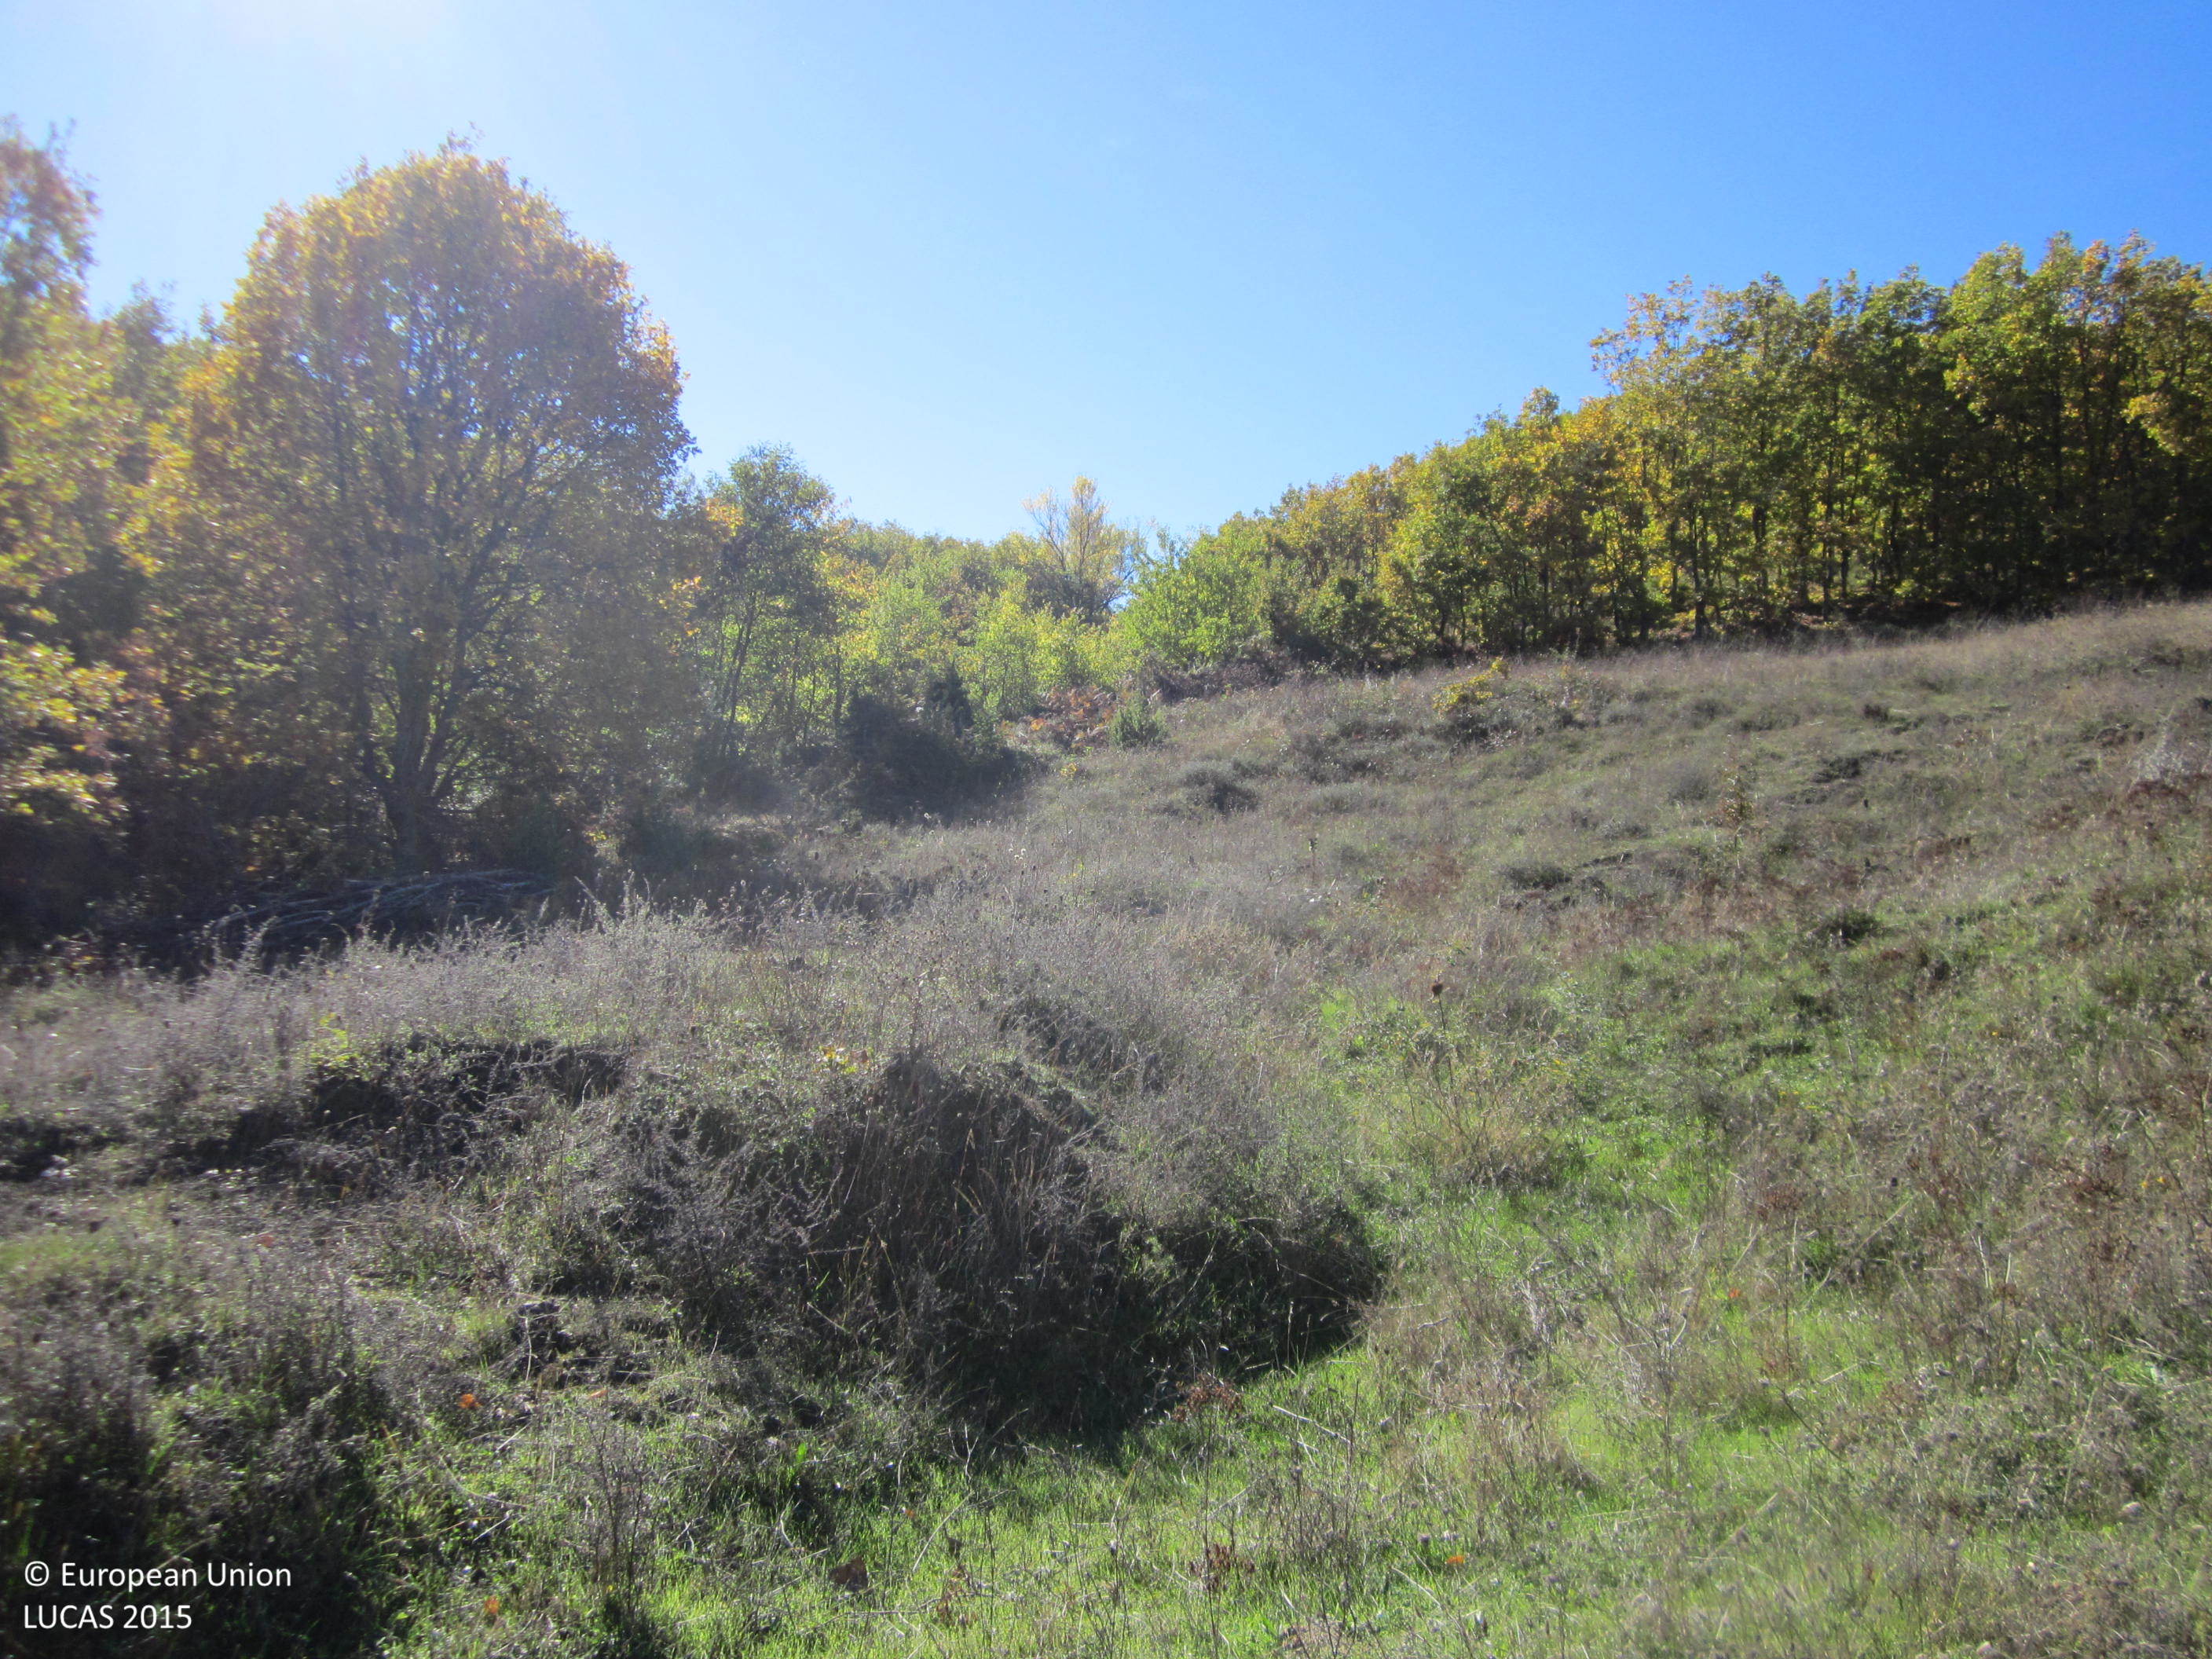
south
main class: Grassland
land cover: Grassland without tree/shrub cover
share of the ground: > 75 %
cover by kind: herbaceous plants 95 %, shrubs 5 %
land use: Agriculture (excluding fallow land and kitchen gardens)
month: November
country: BG
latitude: 41.3718
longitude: 25.6615
